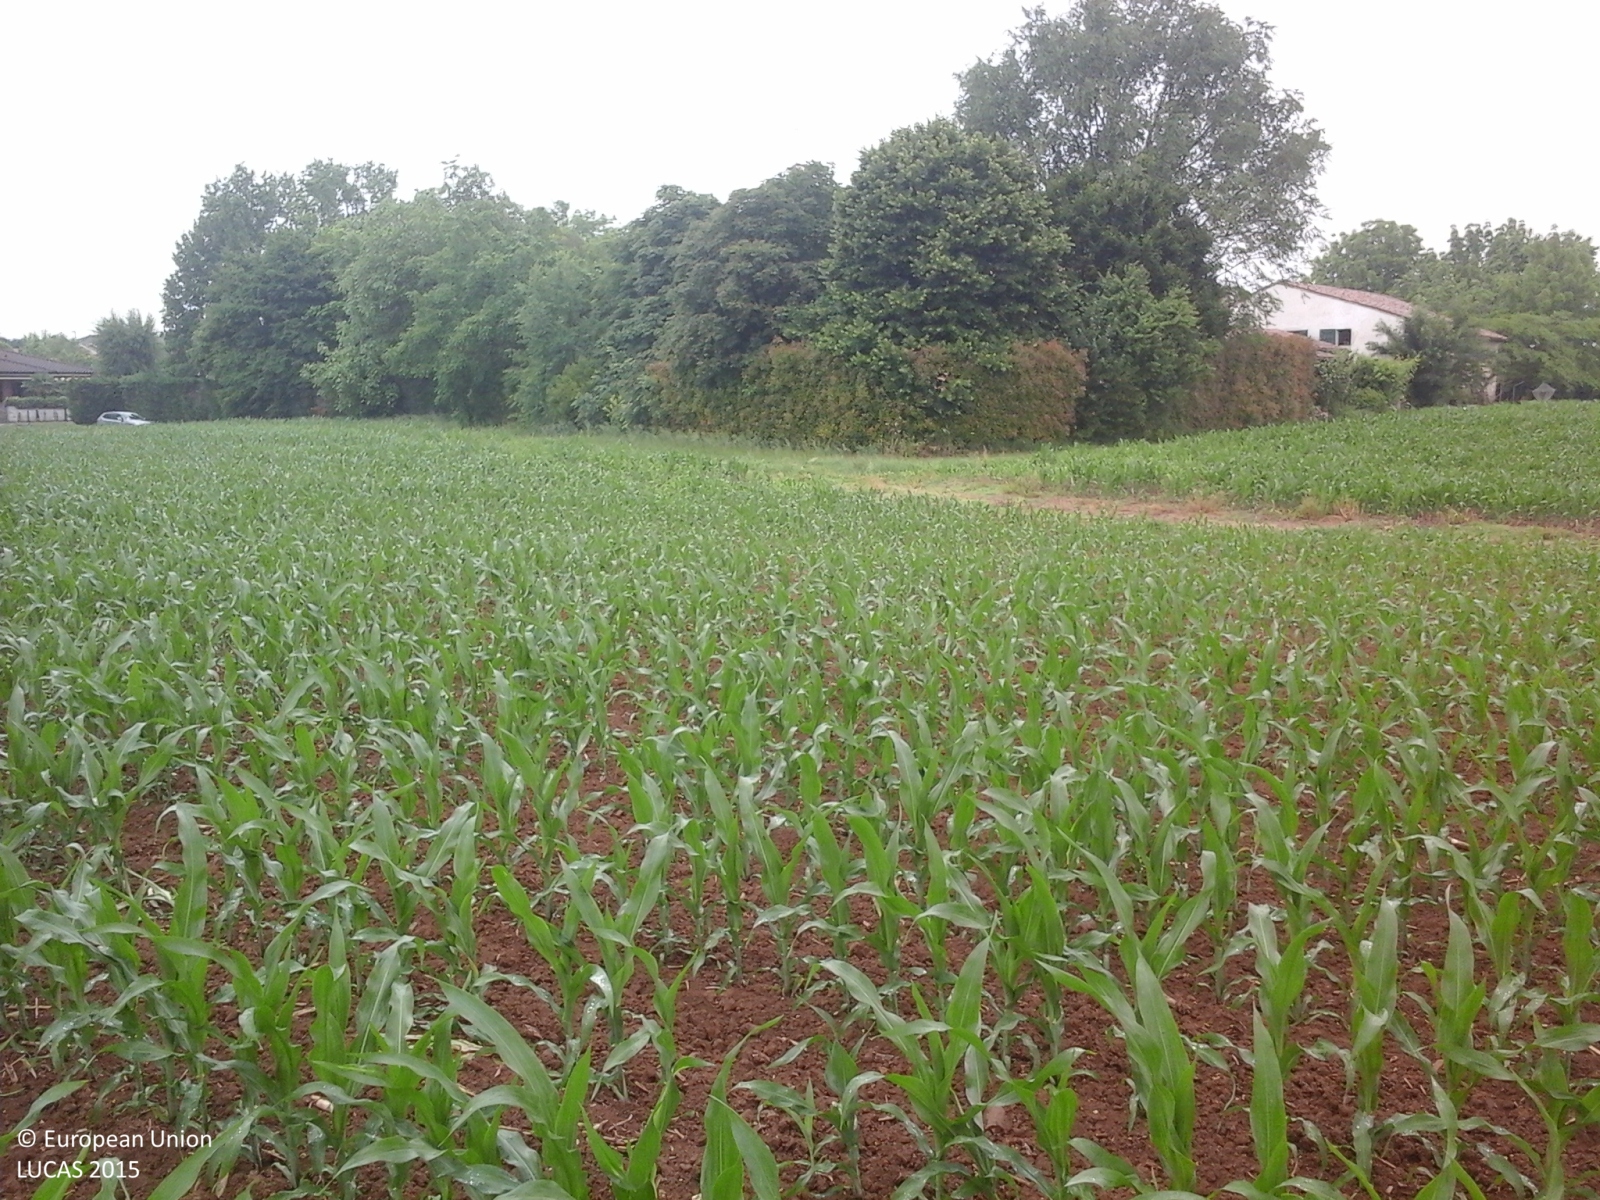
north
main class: Cropland
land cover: Maize
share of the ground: 25 - 50 %
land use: Agriculture (excluding fallow land and kitchen gardens)
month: May
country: IT
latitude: 45.1232
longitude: 10.7487
